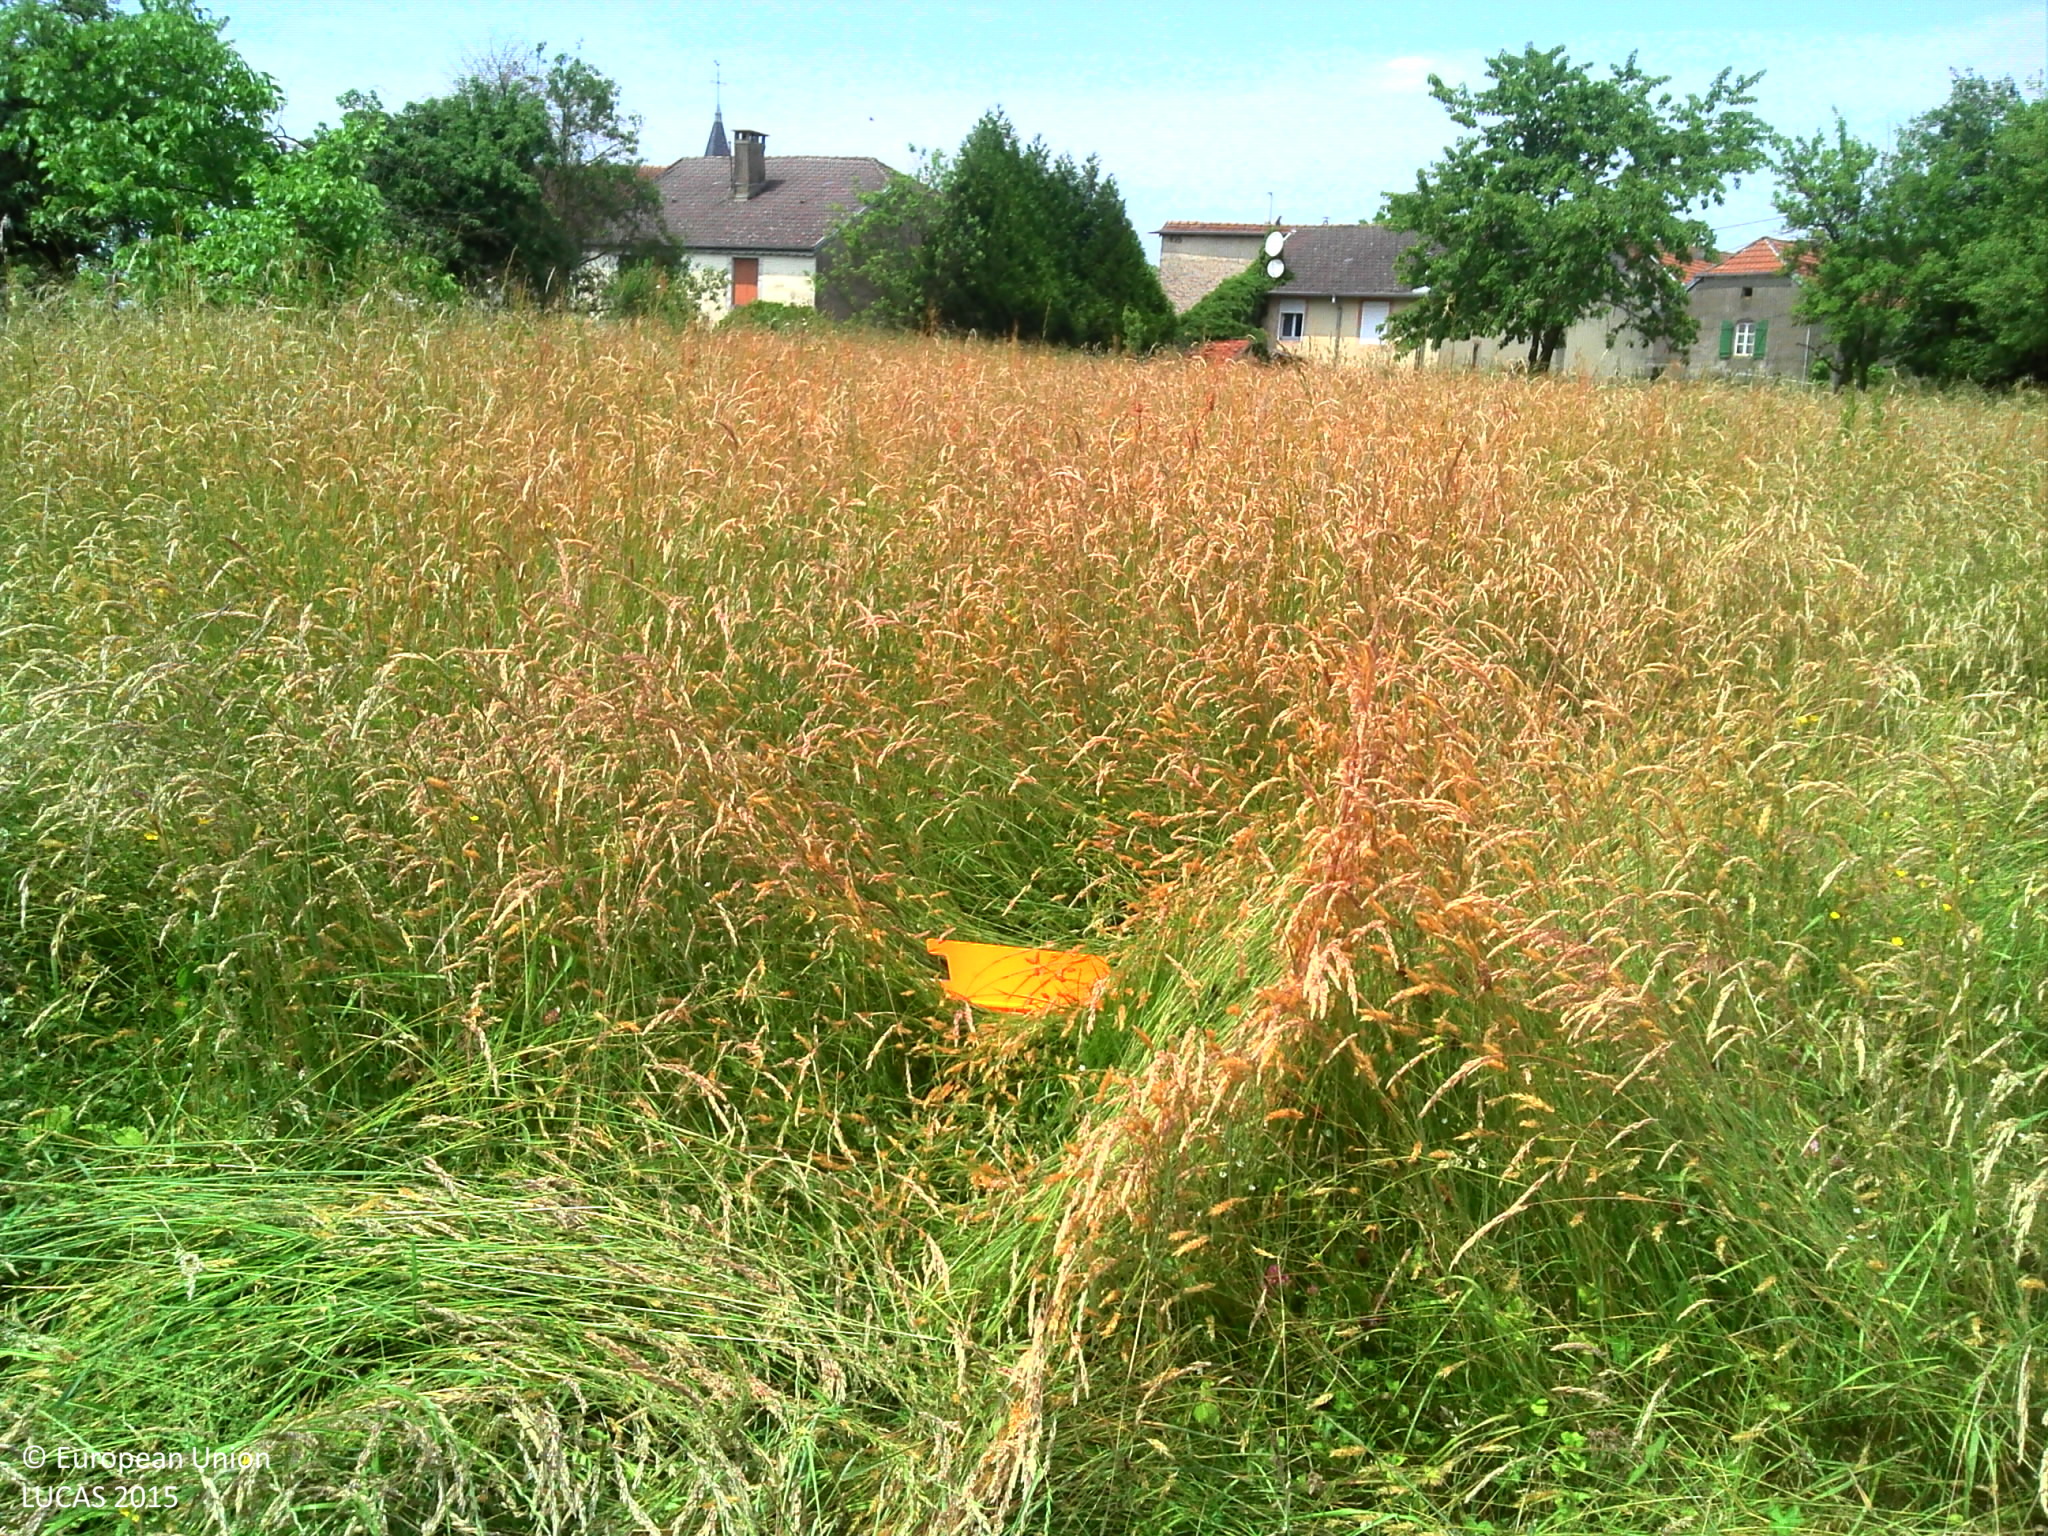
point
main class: Grassland
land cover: Grassland without tree/shrub cover
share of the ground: > 75 %
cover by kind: herbaceous plants 100 %
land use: Agriculture (excluding fallow land and kitchen gardens)
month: June
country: FR
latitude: 47.8525
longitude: 6.2188
